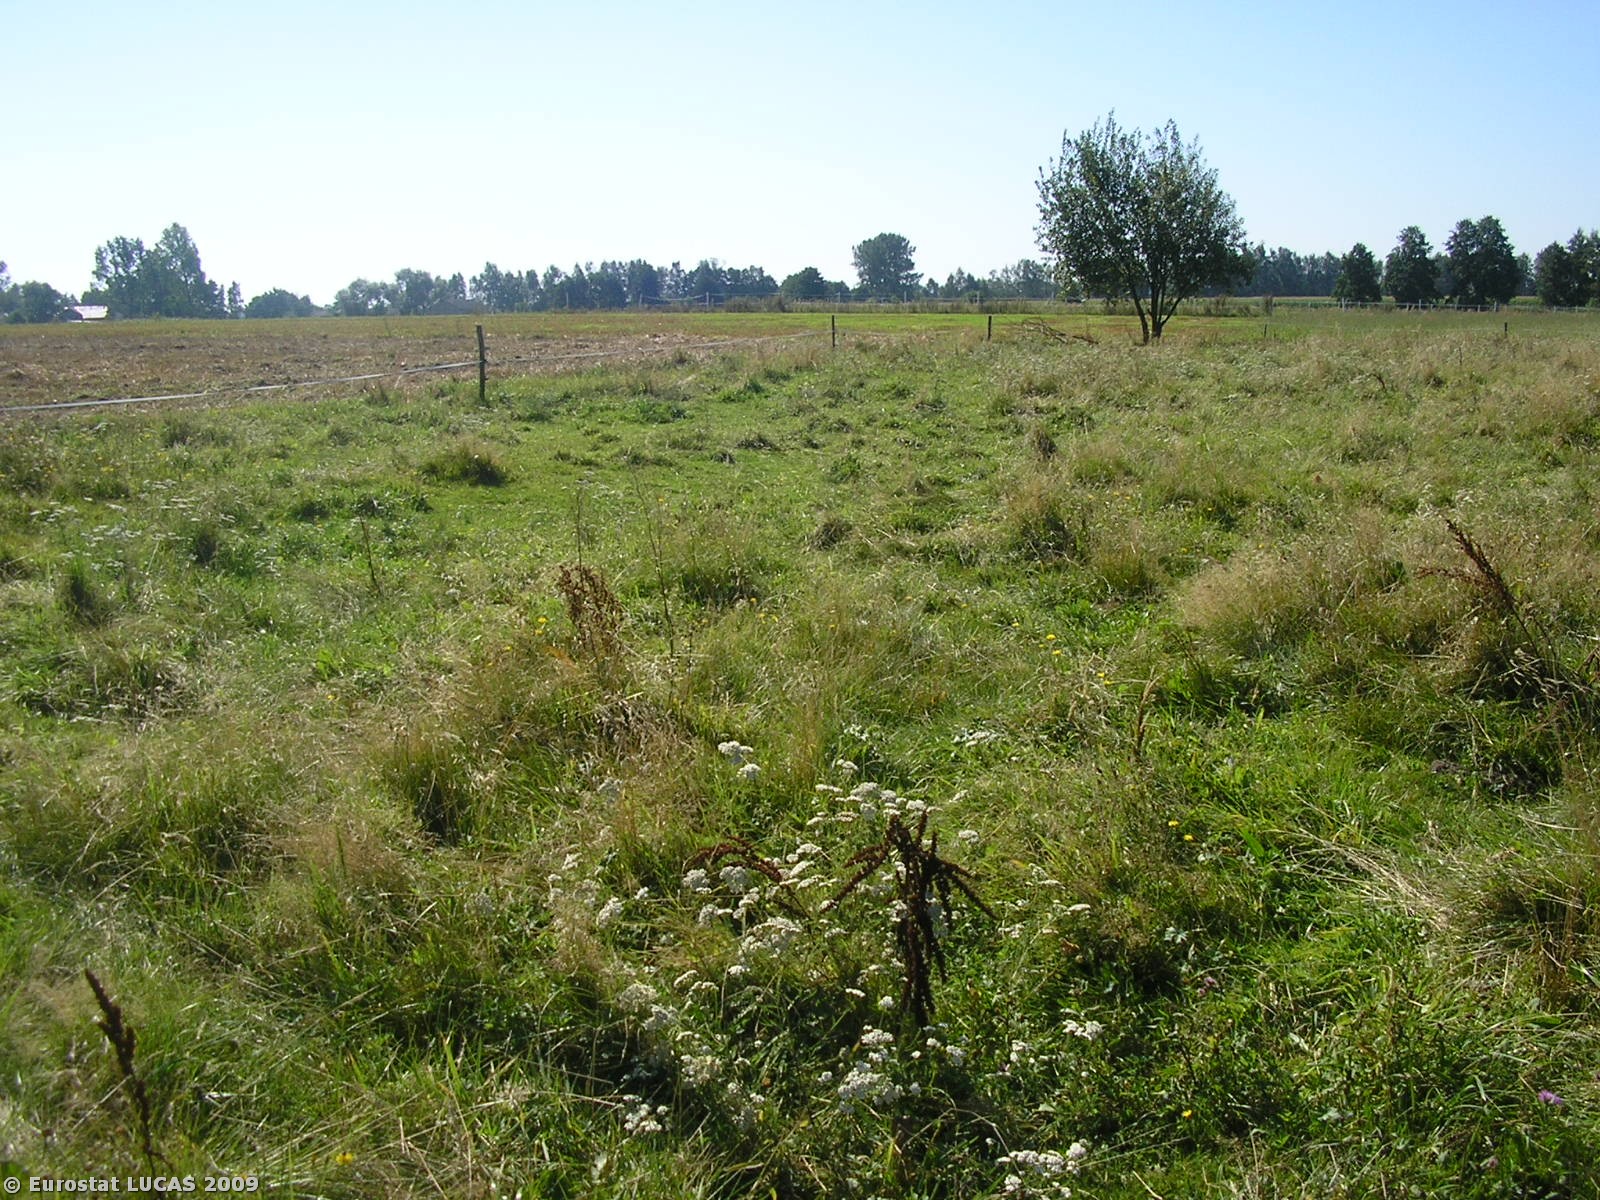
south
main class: Grassland
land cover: Grassland without tree/shrub cover
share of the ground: > 75 %
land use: Agriculture (excluding fallow land and kitchen gardens)
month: September
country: PL
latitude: 51.9725
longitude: 19.5631
